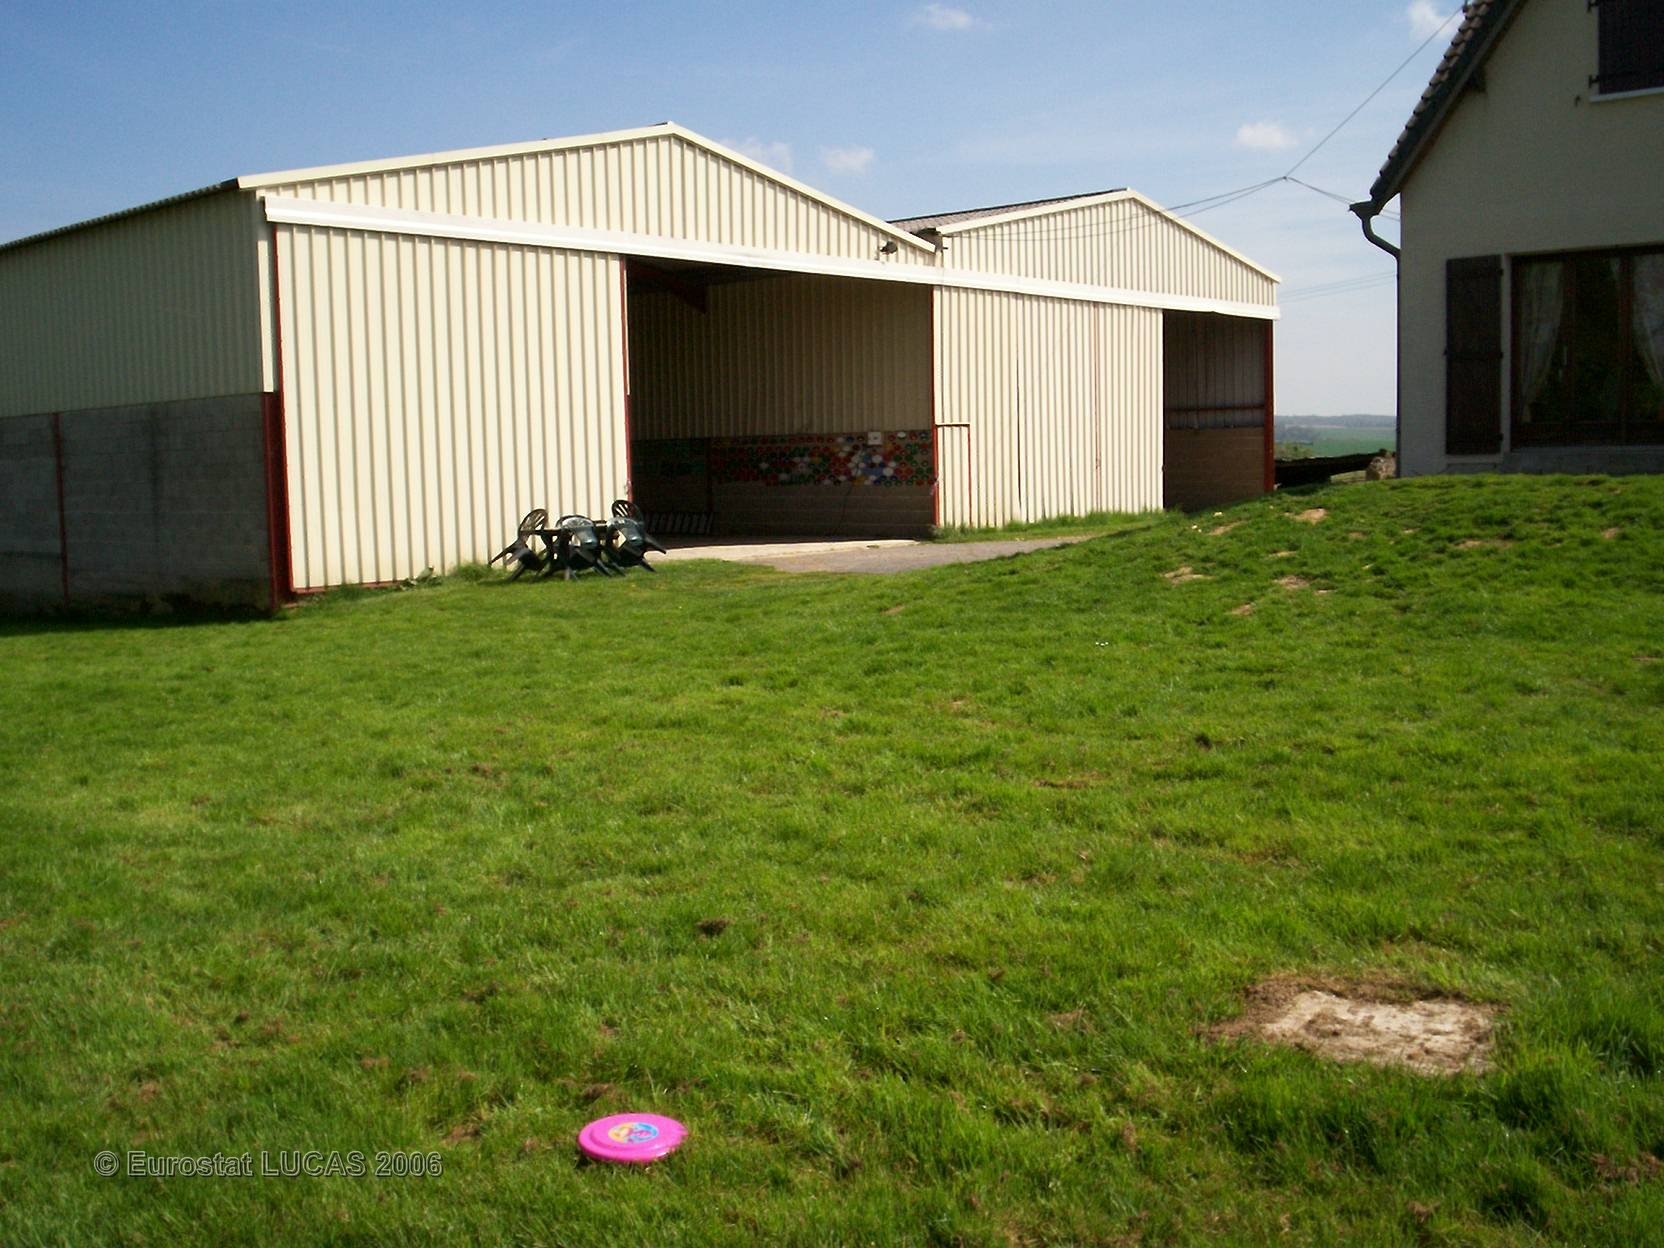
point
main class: Grassland
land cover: Grassland with sparse tree/shrub cover
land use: Residential
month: April
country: FR
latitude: 49.6328
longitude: 4.4162
